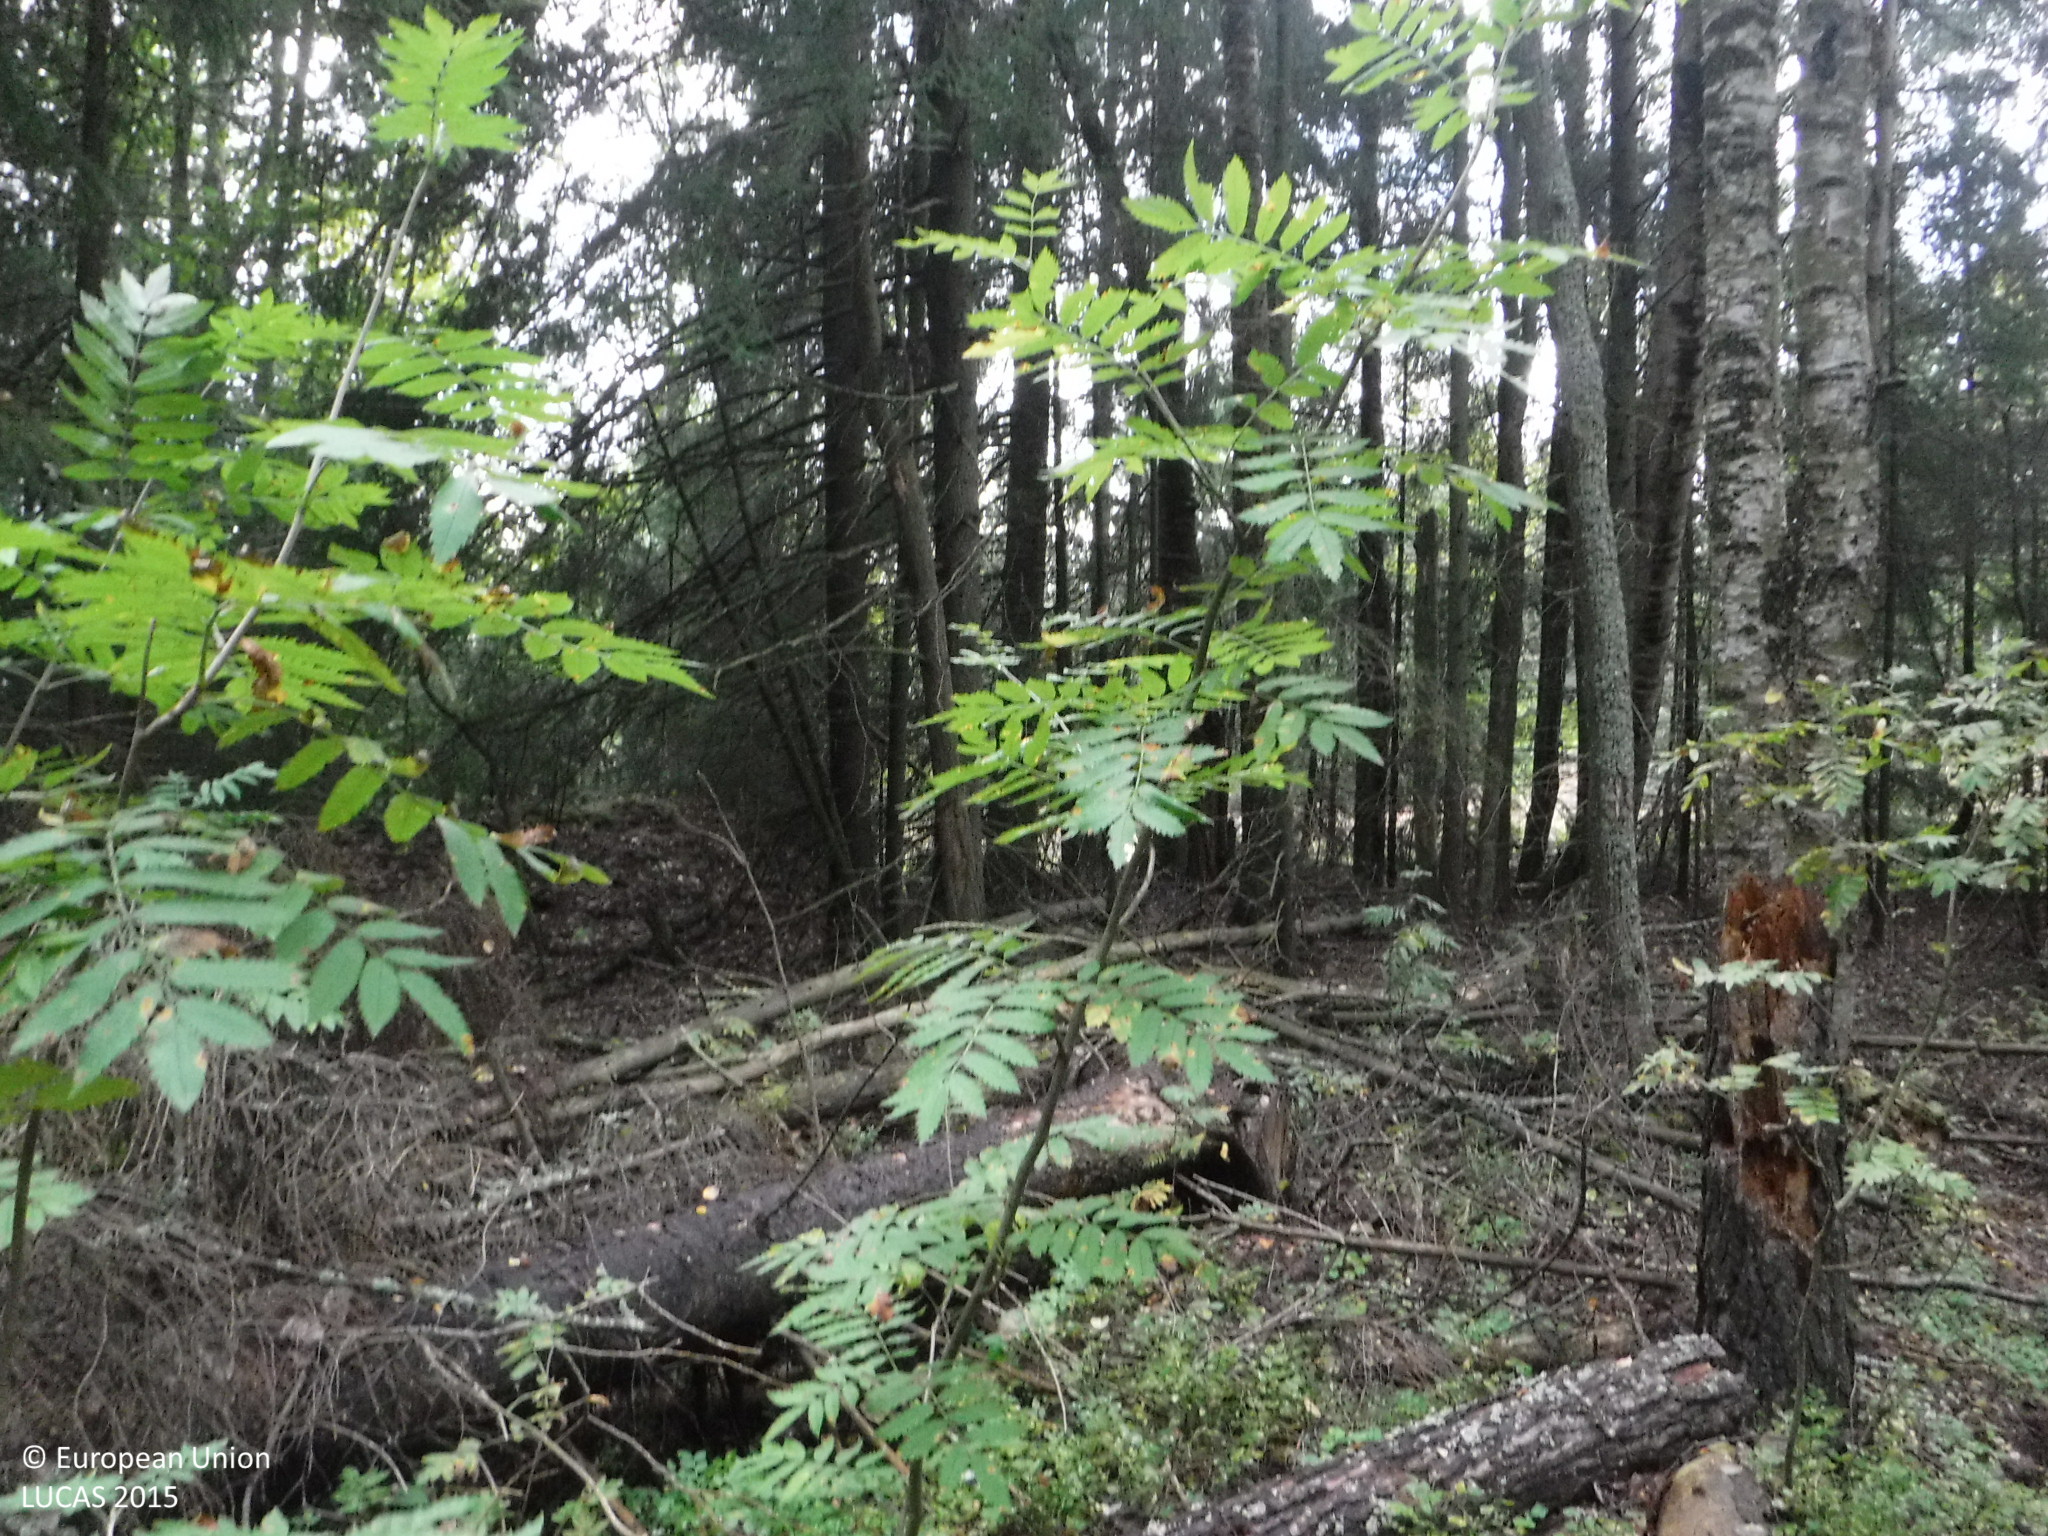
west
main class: Woodland
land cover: Other mixed woodland
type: boreal forest
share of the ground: > 75 %
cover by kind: broadleaved forest trees 40 %, coniferous forest trees 35 %, herbaceous plants 10 %, unconsolidated bare surface 10 %, shrubs 5 %
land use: Semi-natural and natural areas not in use
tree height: > 5 m
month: September
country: FI
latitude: 61.3418
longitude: 22.0397
